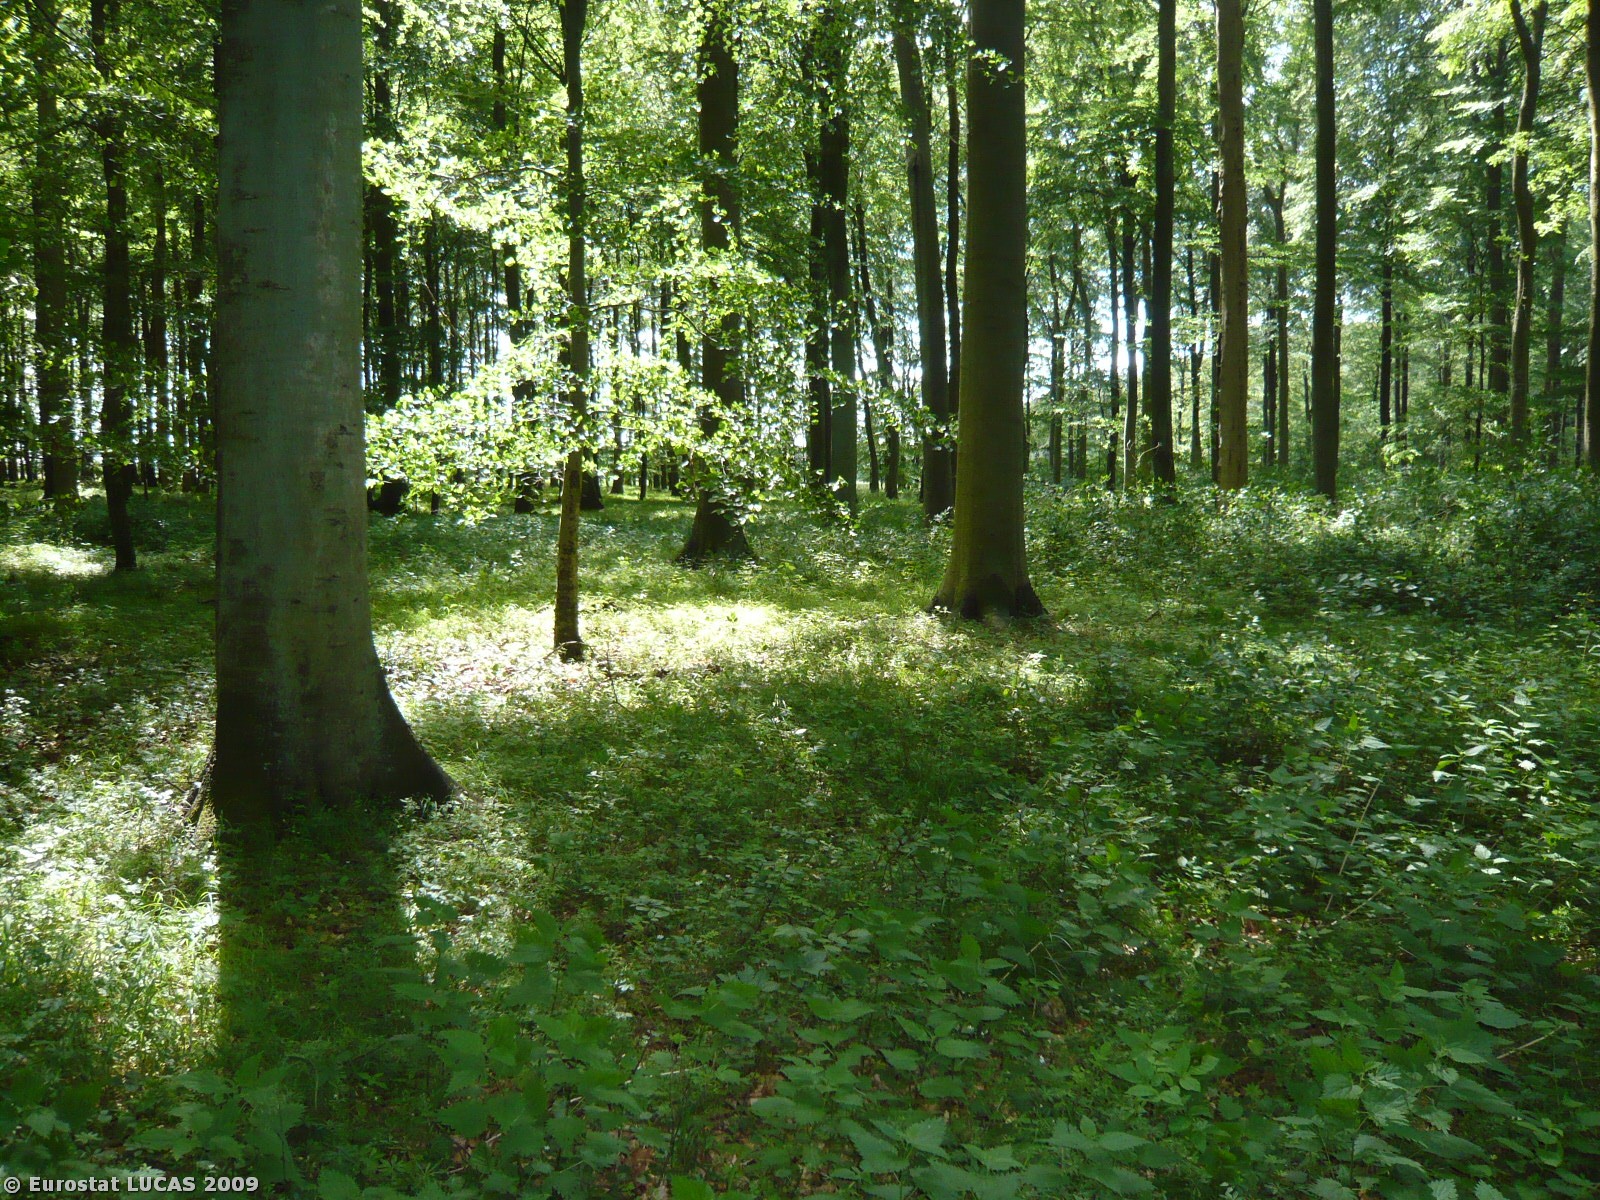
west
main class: Woodland
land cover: Broadleaved woodland
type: mesophytic deciduous forest
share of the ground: > 75 %
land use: Forestry
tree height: > 5 m
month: June
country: DK
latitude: 54.8686
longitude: 11.3235
